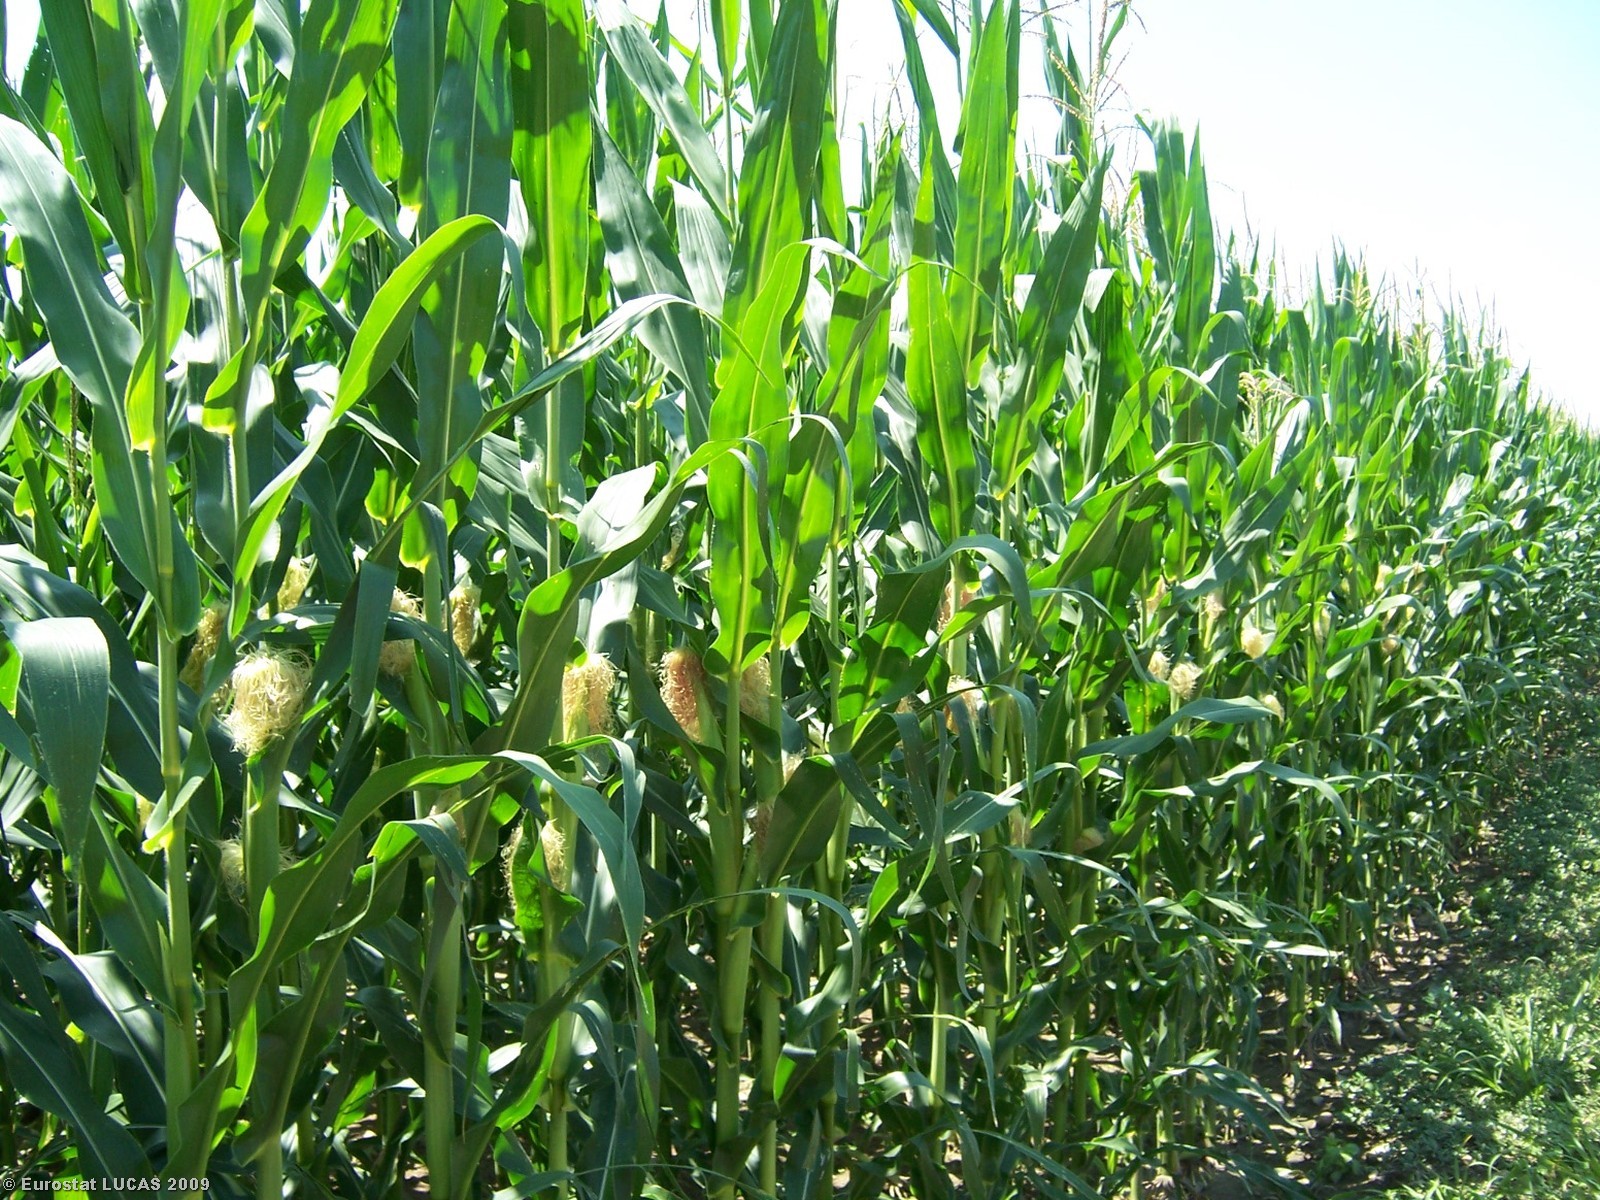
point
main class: Cropland
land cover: Maize
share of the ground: > 75 %
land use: Agriculture (excluding fallow land and kitchen gardens)
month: July
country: IT
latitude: 45.2165
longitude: 8.0805
